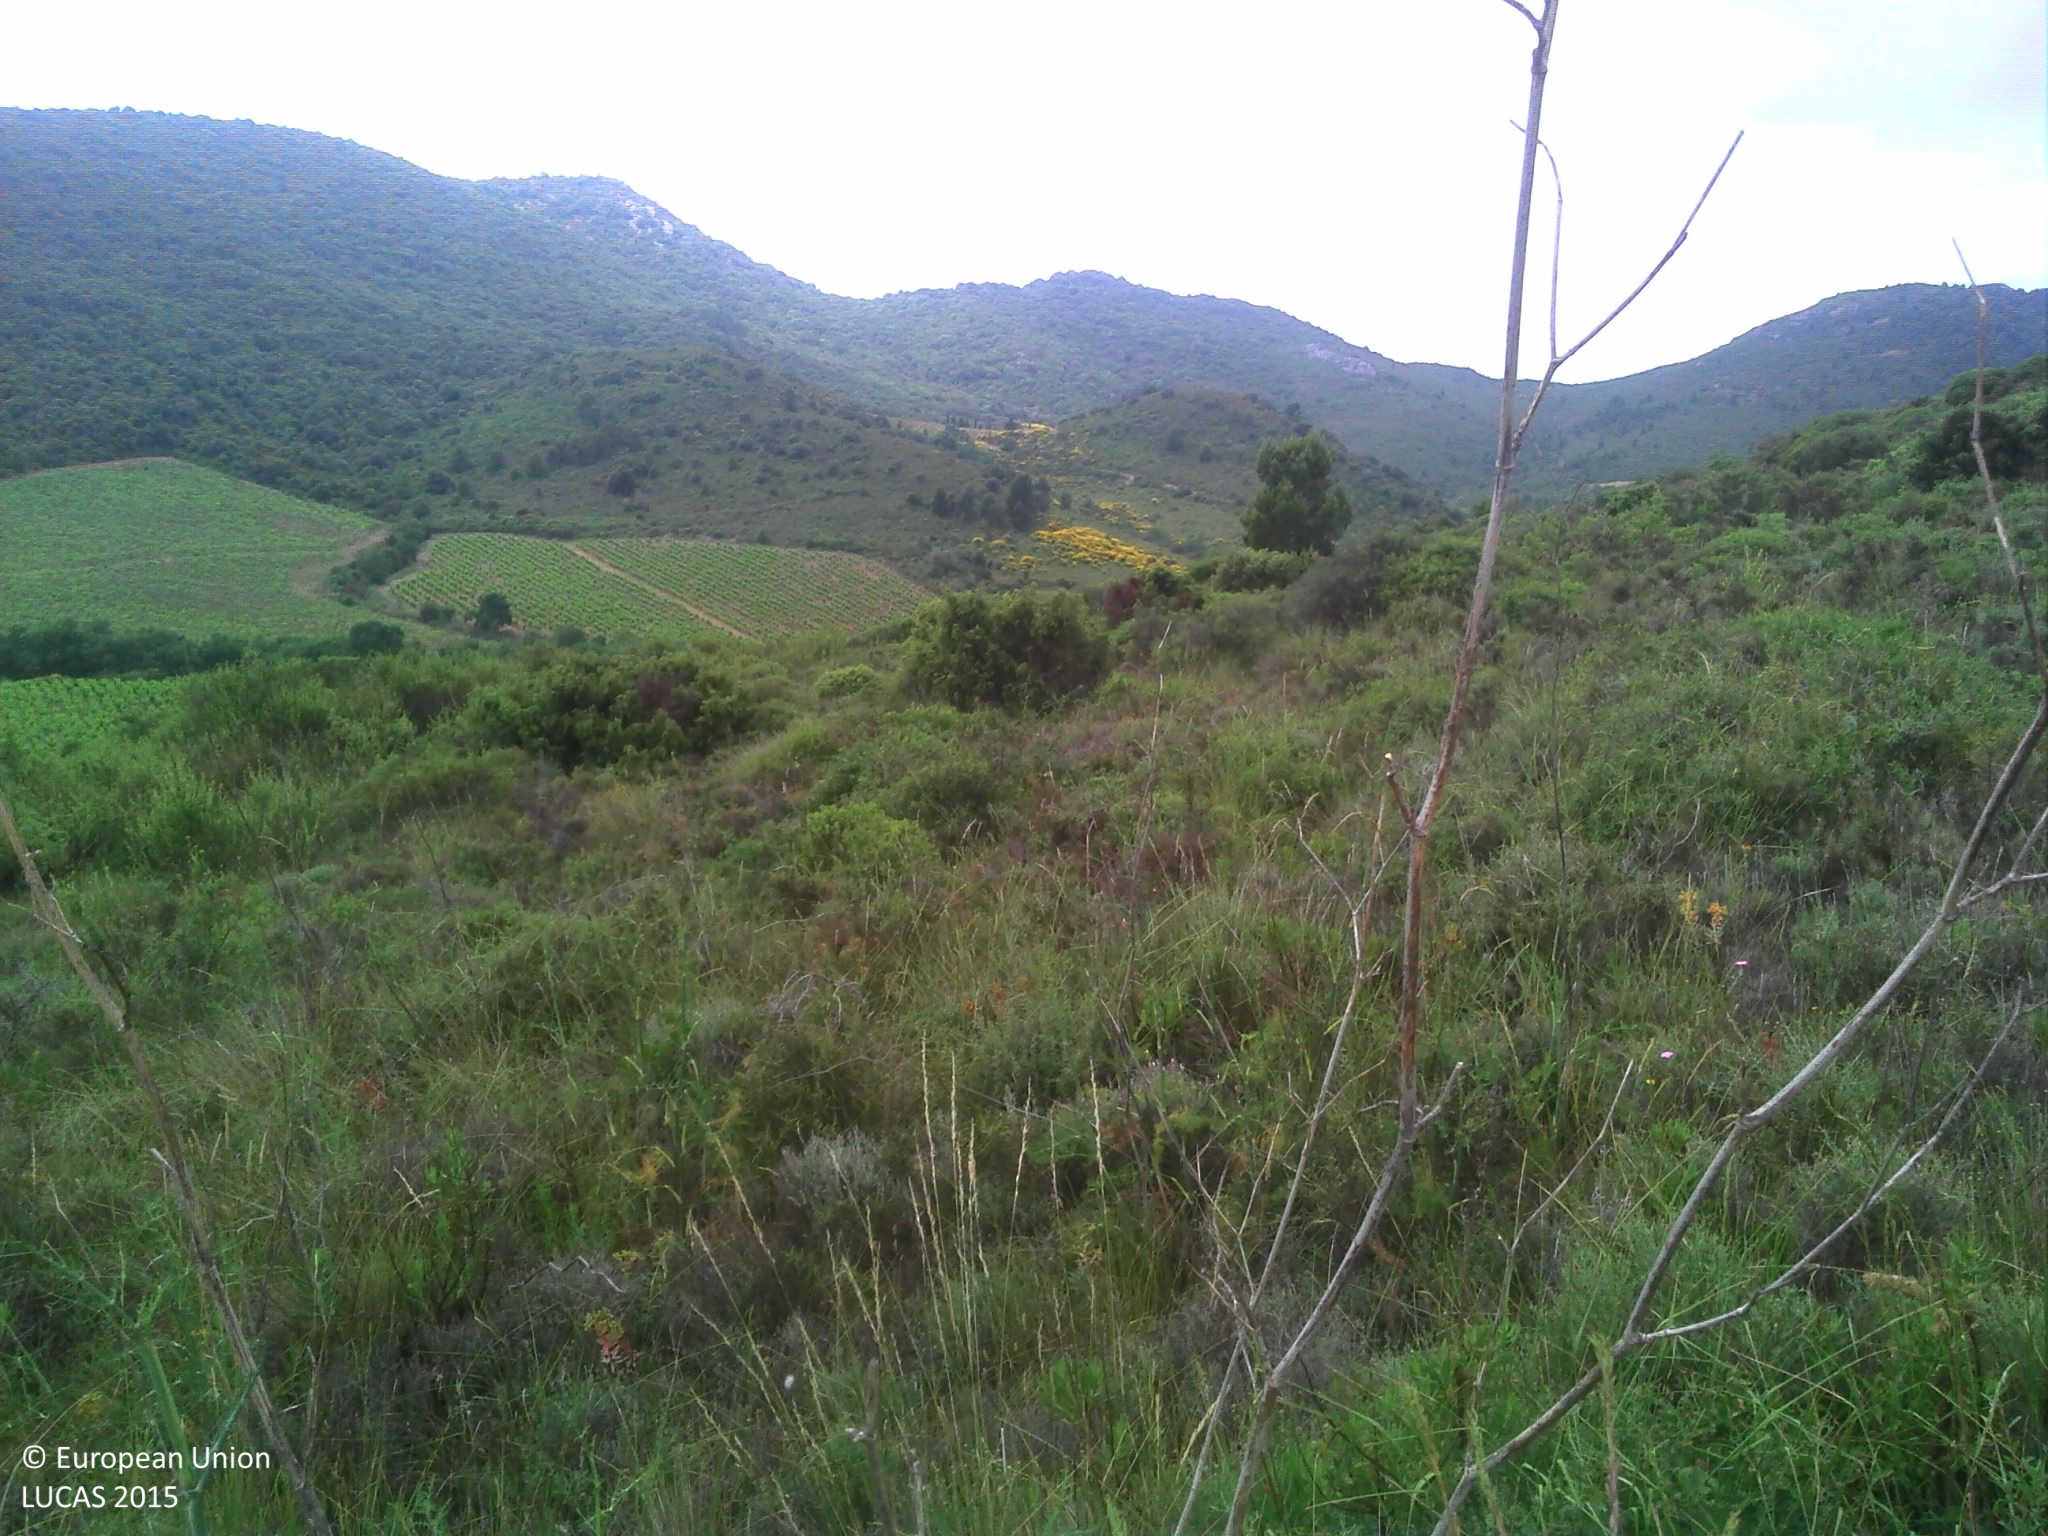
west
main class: Shrubland
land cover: Shrubland without tree cover
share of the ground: > 75 %
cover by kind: shrubs 90 %, herbaceous plants 10 %
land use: Semi-natural and natural areas not in use
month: June
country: FR
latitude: 42.9783
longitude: 2.8123
